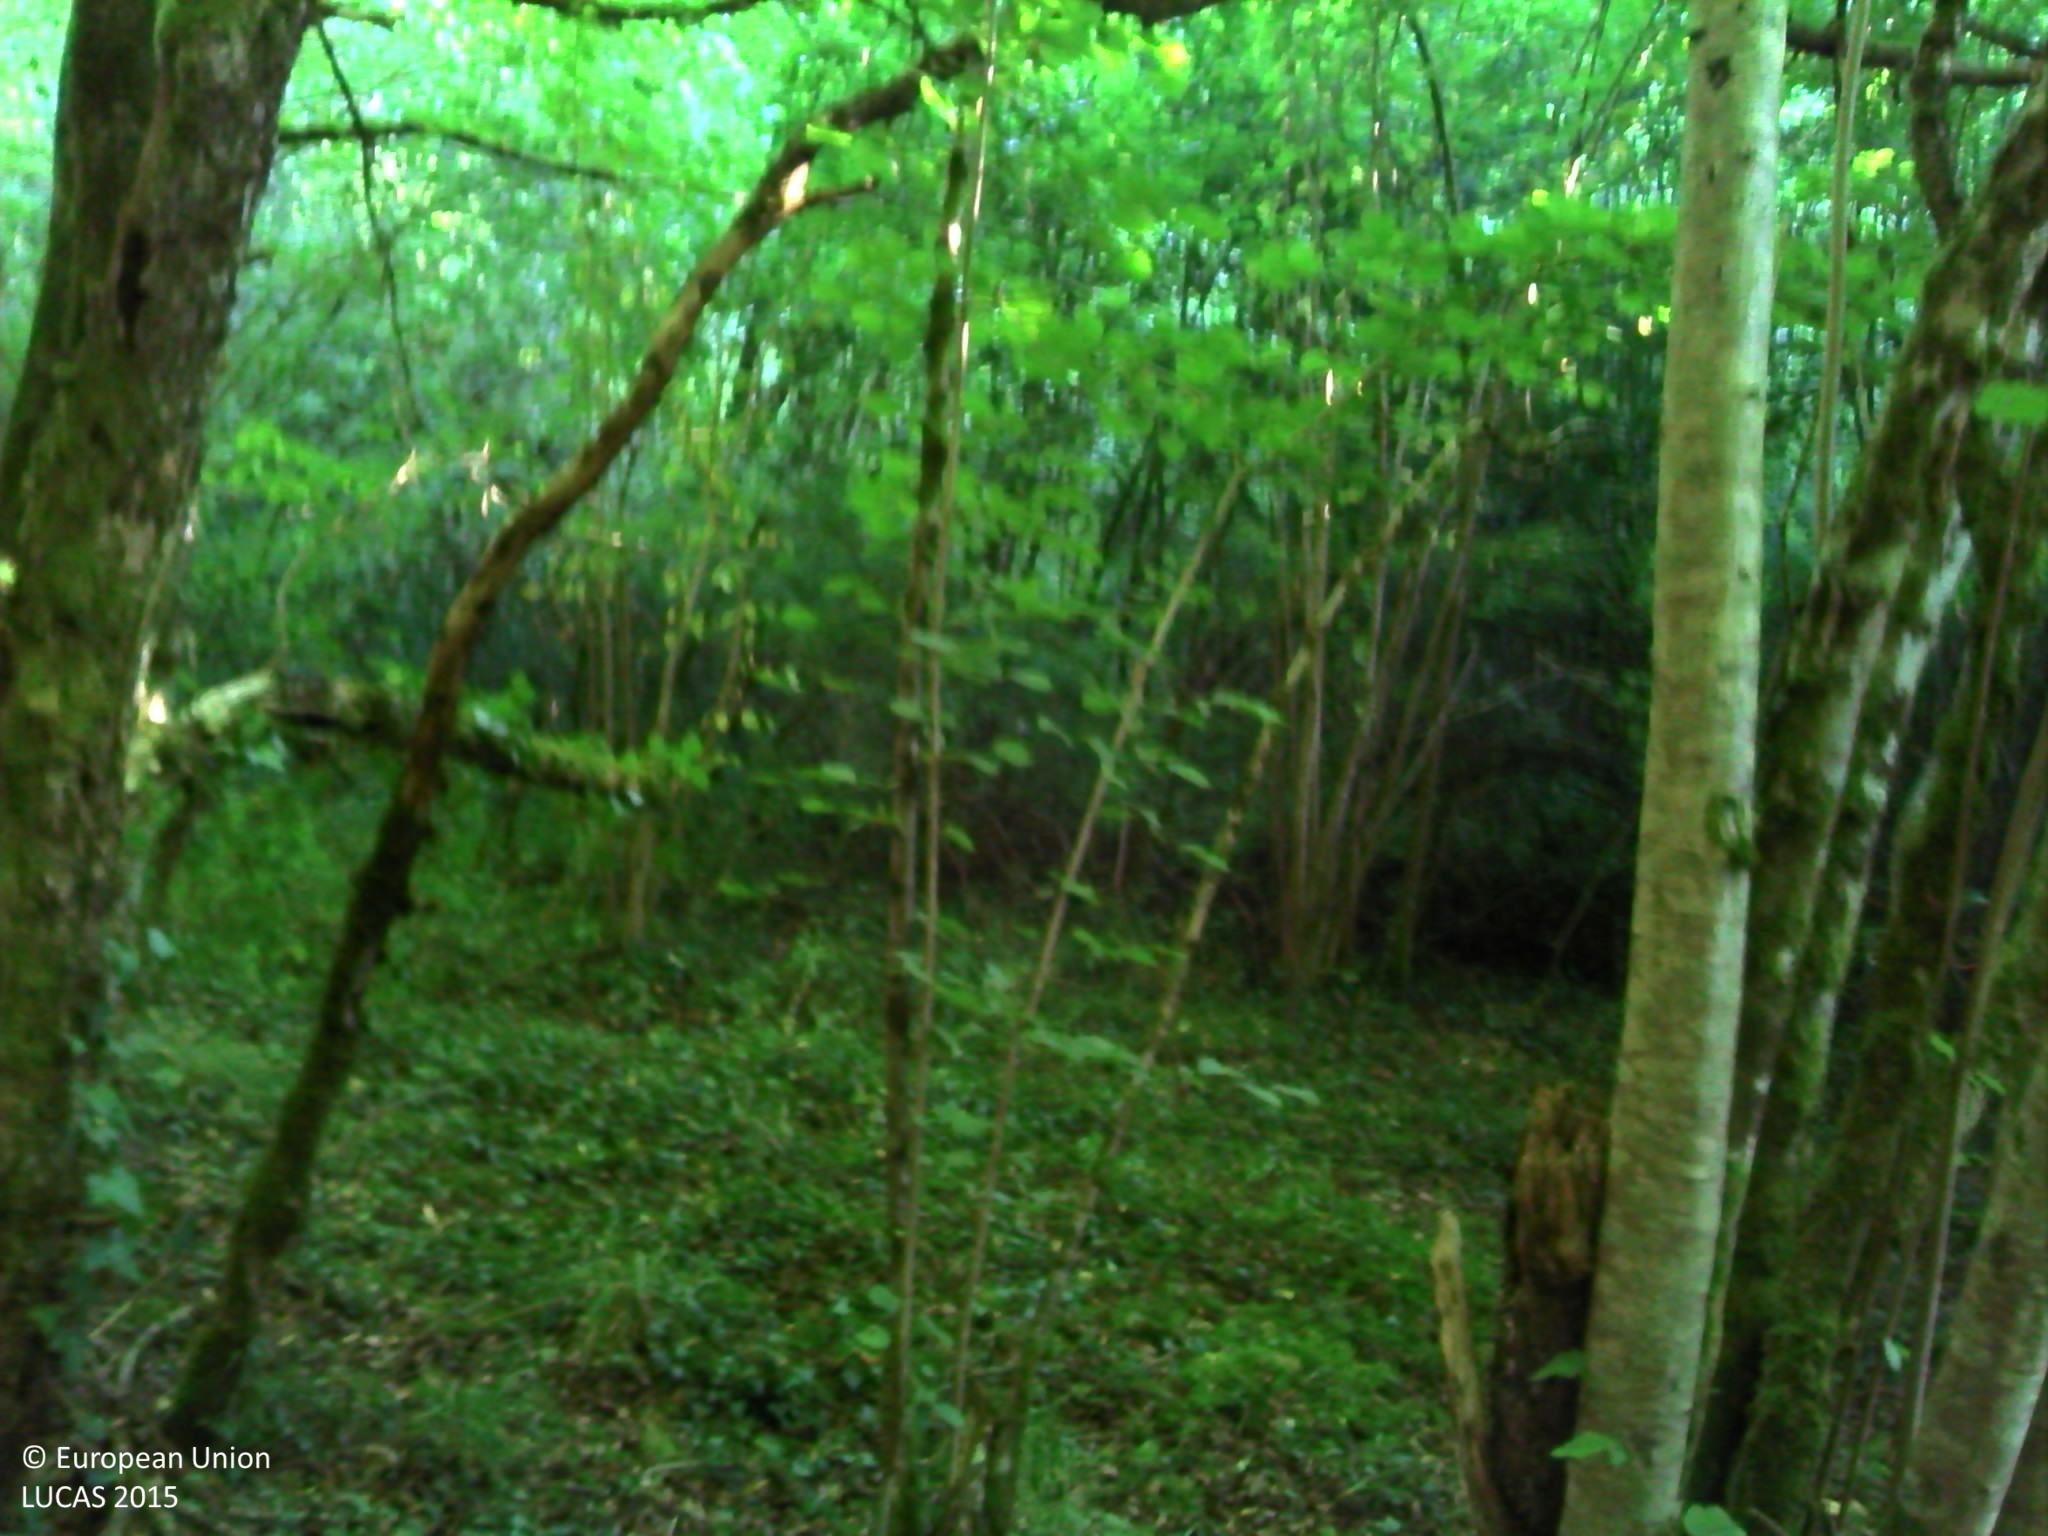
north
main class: Woodland
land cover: Broadleaved woodland
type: acidophilous oak and oak-birch forest
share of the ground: > 75 %
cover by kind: broadleaved forest trees 80 %, shrubs 10 %, herbaceous plants 5 %, lichens and mosses 5 %
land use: Forestry
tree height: > 5 m
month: July
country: FR
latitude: 45.3229
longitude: 1.0485
